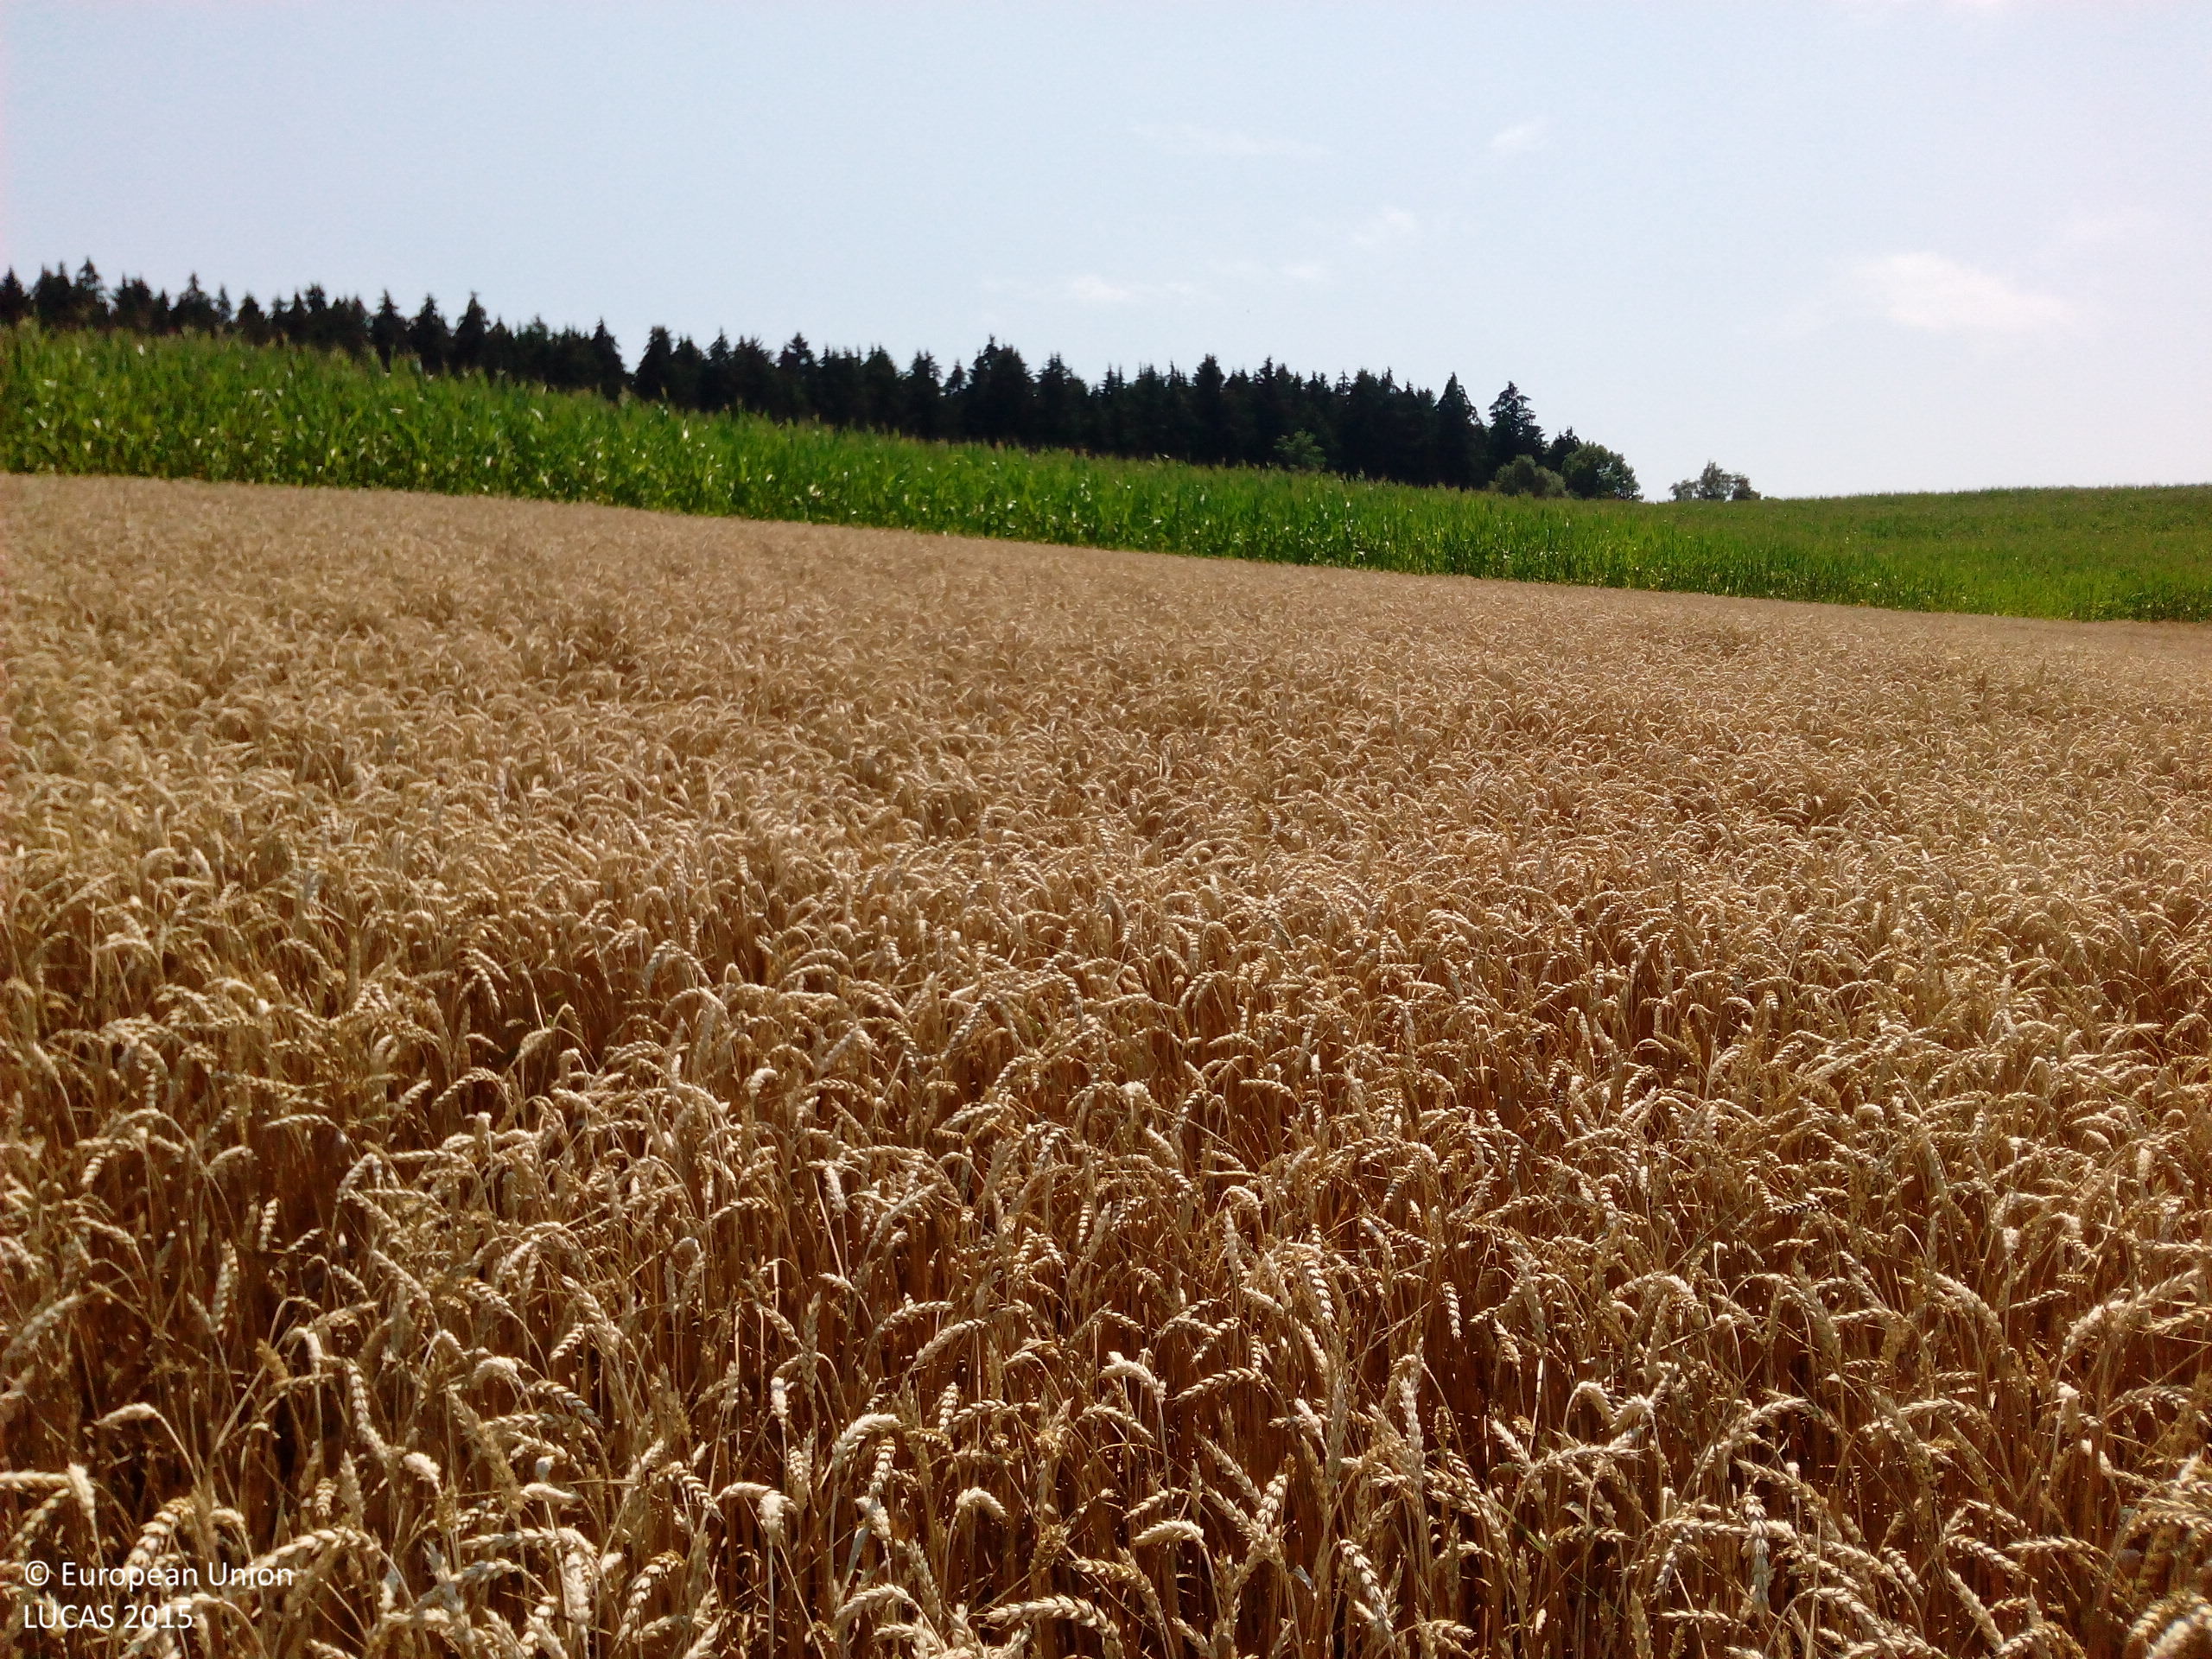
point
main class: Cropland
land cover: Maize
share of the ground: > 75 %
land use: Agriculture (excluding fallow land and kitchen gardens)
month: July
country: DE
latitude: 48.4546
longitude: 12.9334
